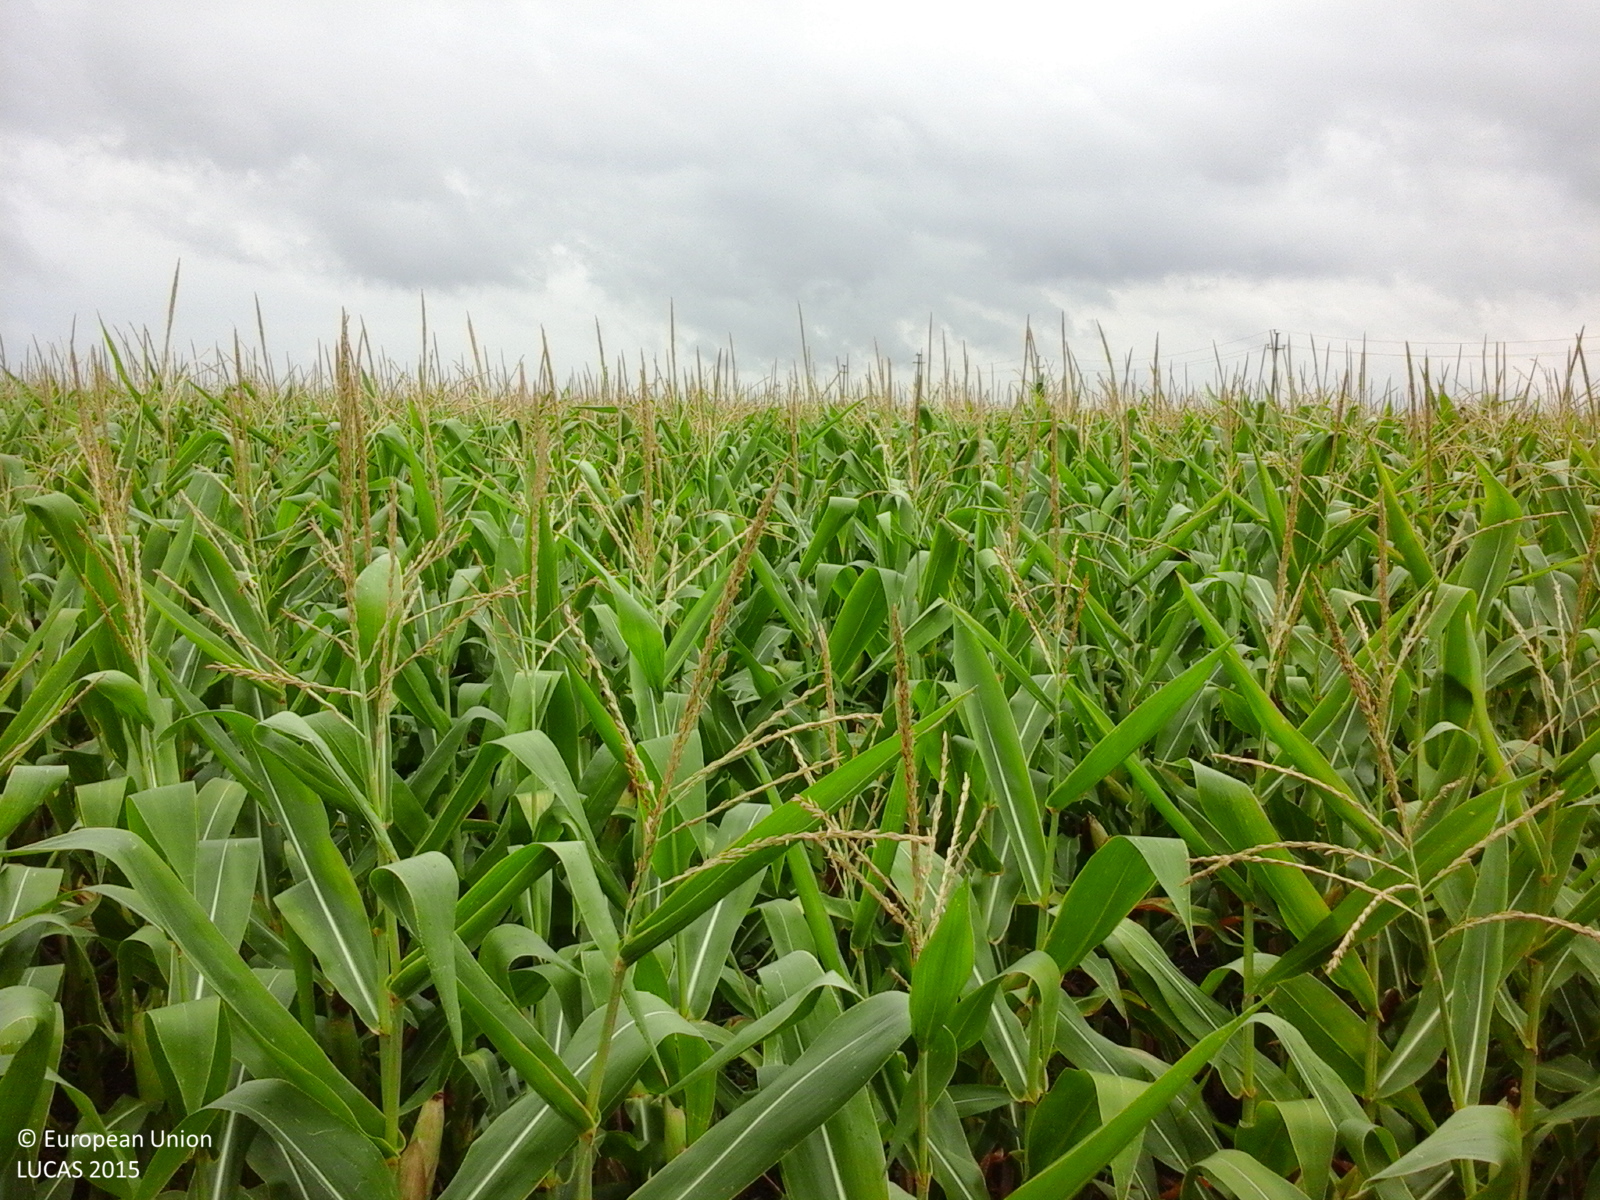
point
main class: Cropland
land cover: Maize
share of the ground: > 75 %
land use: Agriculture (excluding fallow land and kitchen gardens)
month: August
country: RO
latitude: 46.0527
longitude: 20.6631
